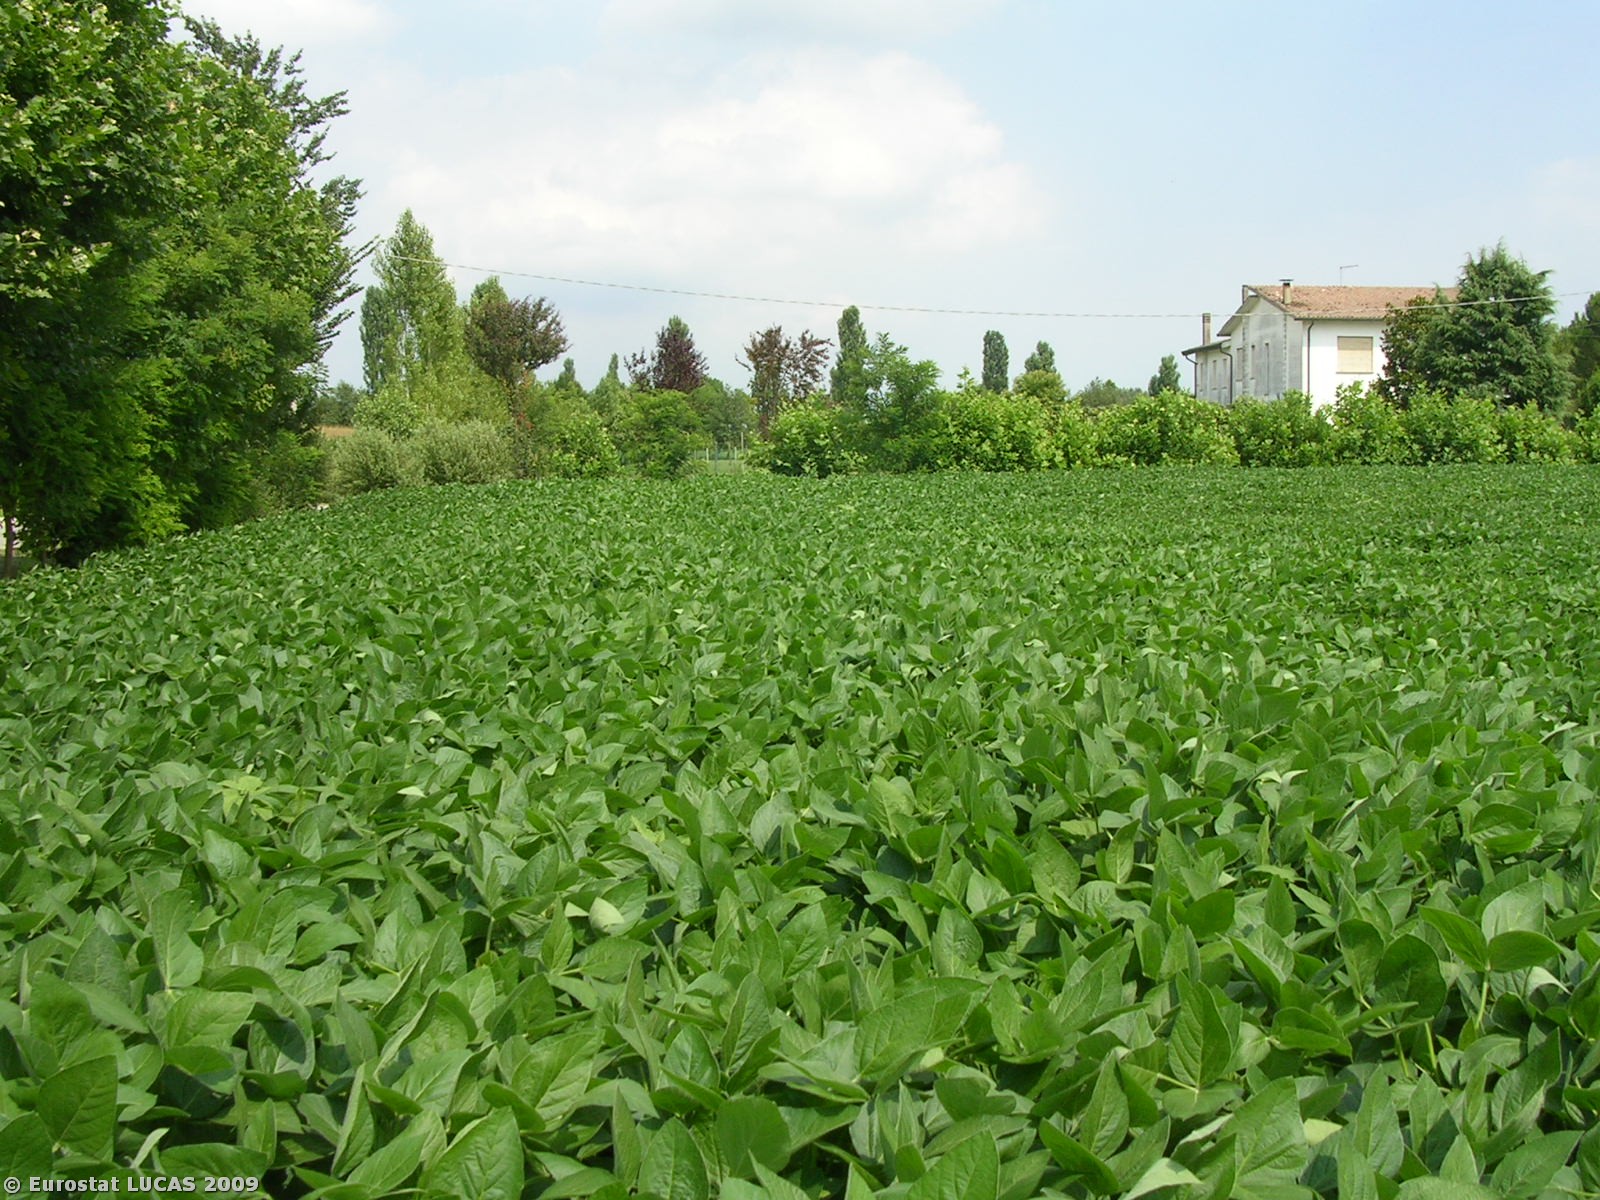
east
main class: Cropland
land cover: Soya
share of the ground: > 75 %
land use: Agriculture (excluding fallow land and kitchen gardens)
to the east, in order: Soya; Managed hedges; Ditches and canals; Grass margins; Paved roads, cycling and walking lanes; Grass margins; Fences; Electric lines; Grassland with sparse tree/shrub cover; Grassland without tree/shrub cover; Grass margins; Inland running water; Grass margins; Single bushes/trees
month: July
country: IT
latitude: 45.3818
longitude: 11.7467
